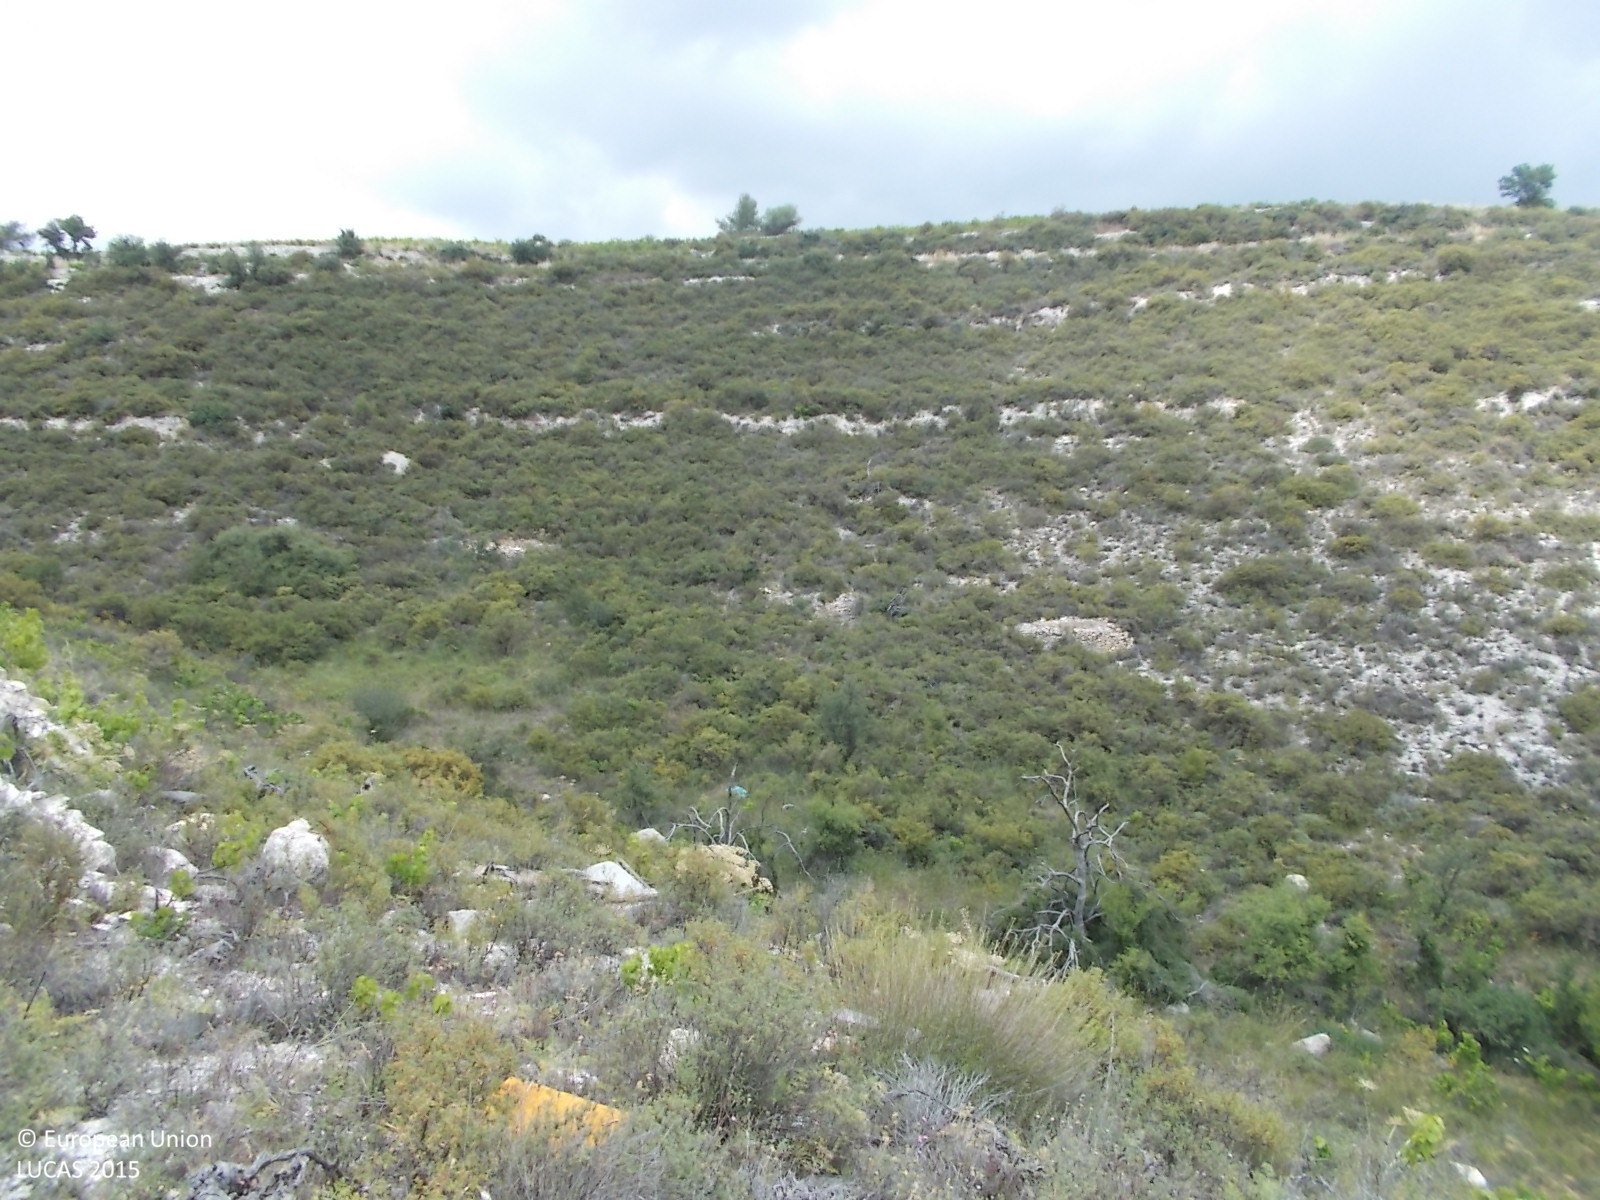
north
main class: Shrubland
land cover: Shrubland without tree cover
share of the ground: 50 - 75 %
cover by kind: shrubs 75 %, consolidated bare surface 15 %, unconsolidated bare surface 10 %
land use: Semi-natural and natural areas not in use
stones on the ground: 25 - 50 %
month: June
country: CY
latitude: 34.8598
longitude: 32.8149
